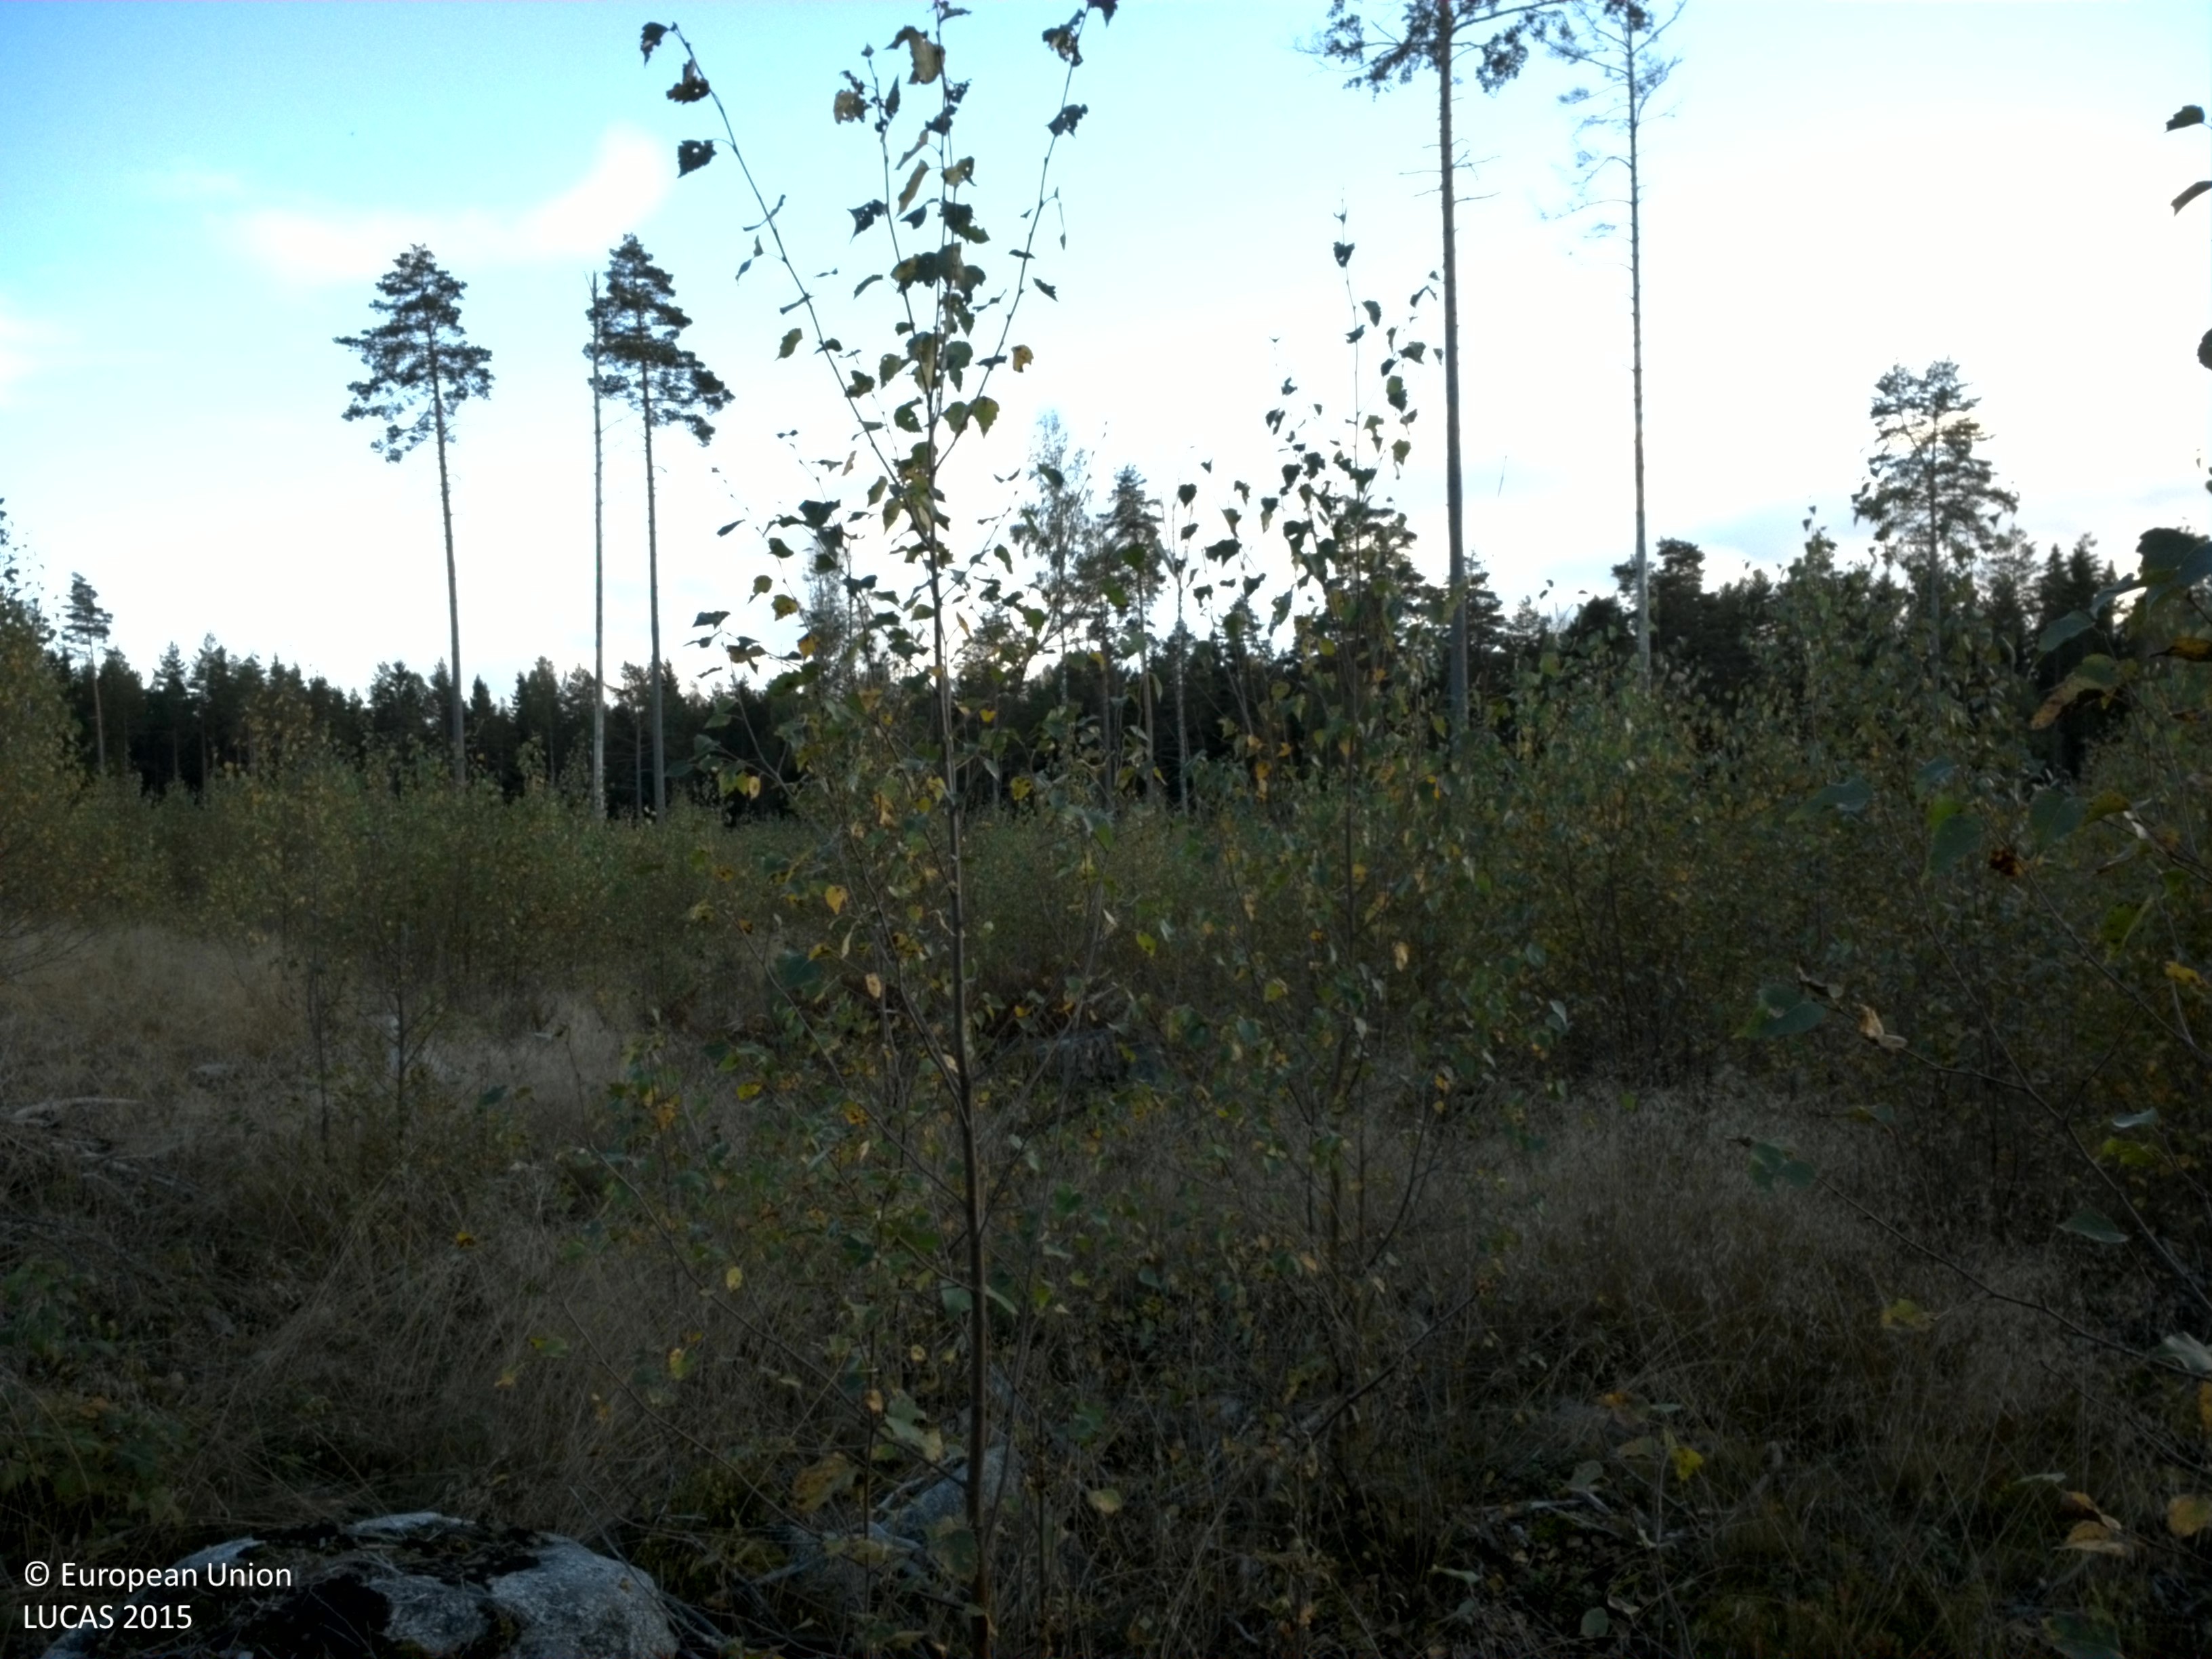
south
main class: Woodland
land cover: Broadleaved woodland
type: boreal forest
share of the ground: 25 - 50 %
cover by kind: broadleaved forest trees 45 %, herbaceous plants 40 %, unconsolidated bare surface 10 %, coniferous forest trees 5 %
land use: Forestry
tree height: < 5 m
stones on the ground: < 10 %
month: September
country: SE
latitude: 59.9736
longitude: 16.5659
